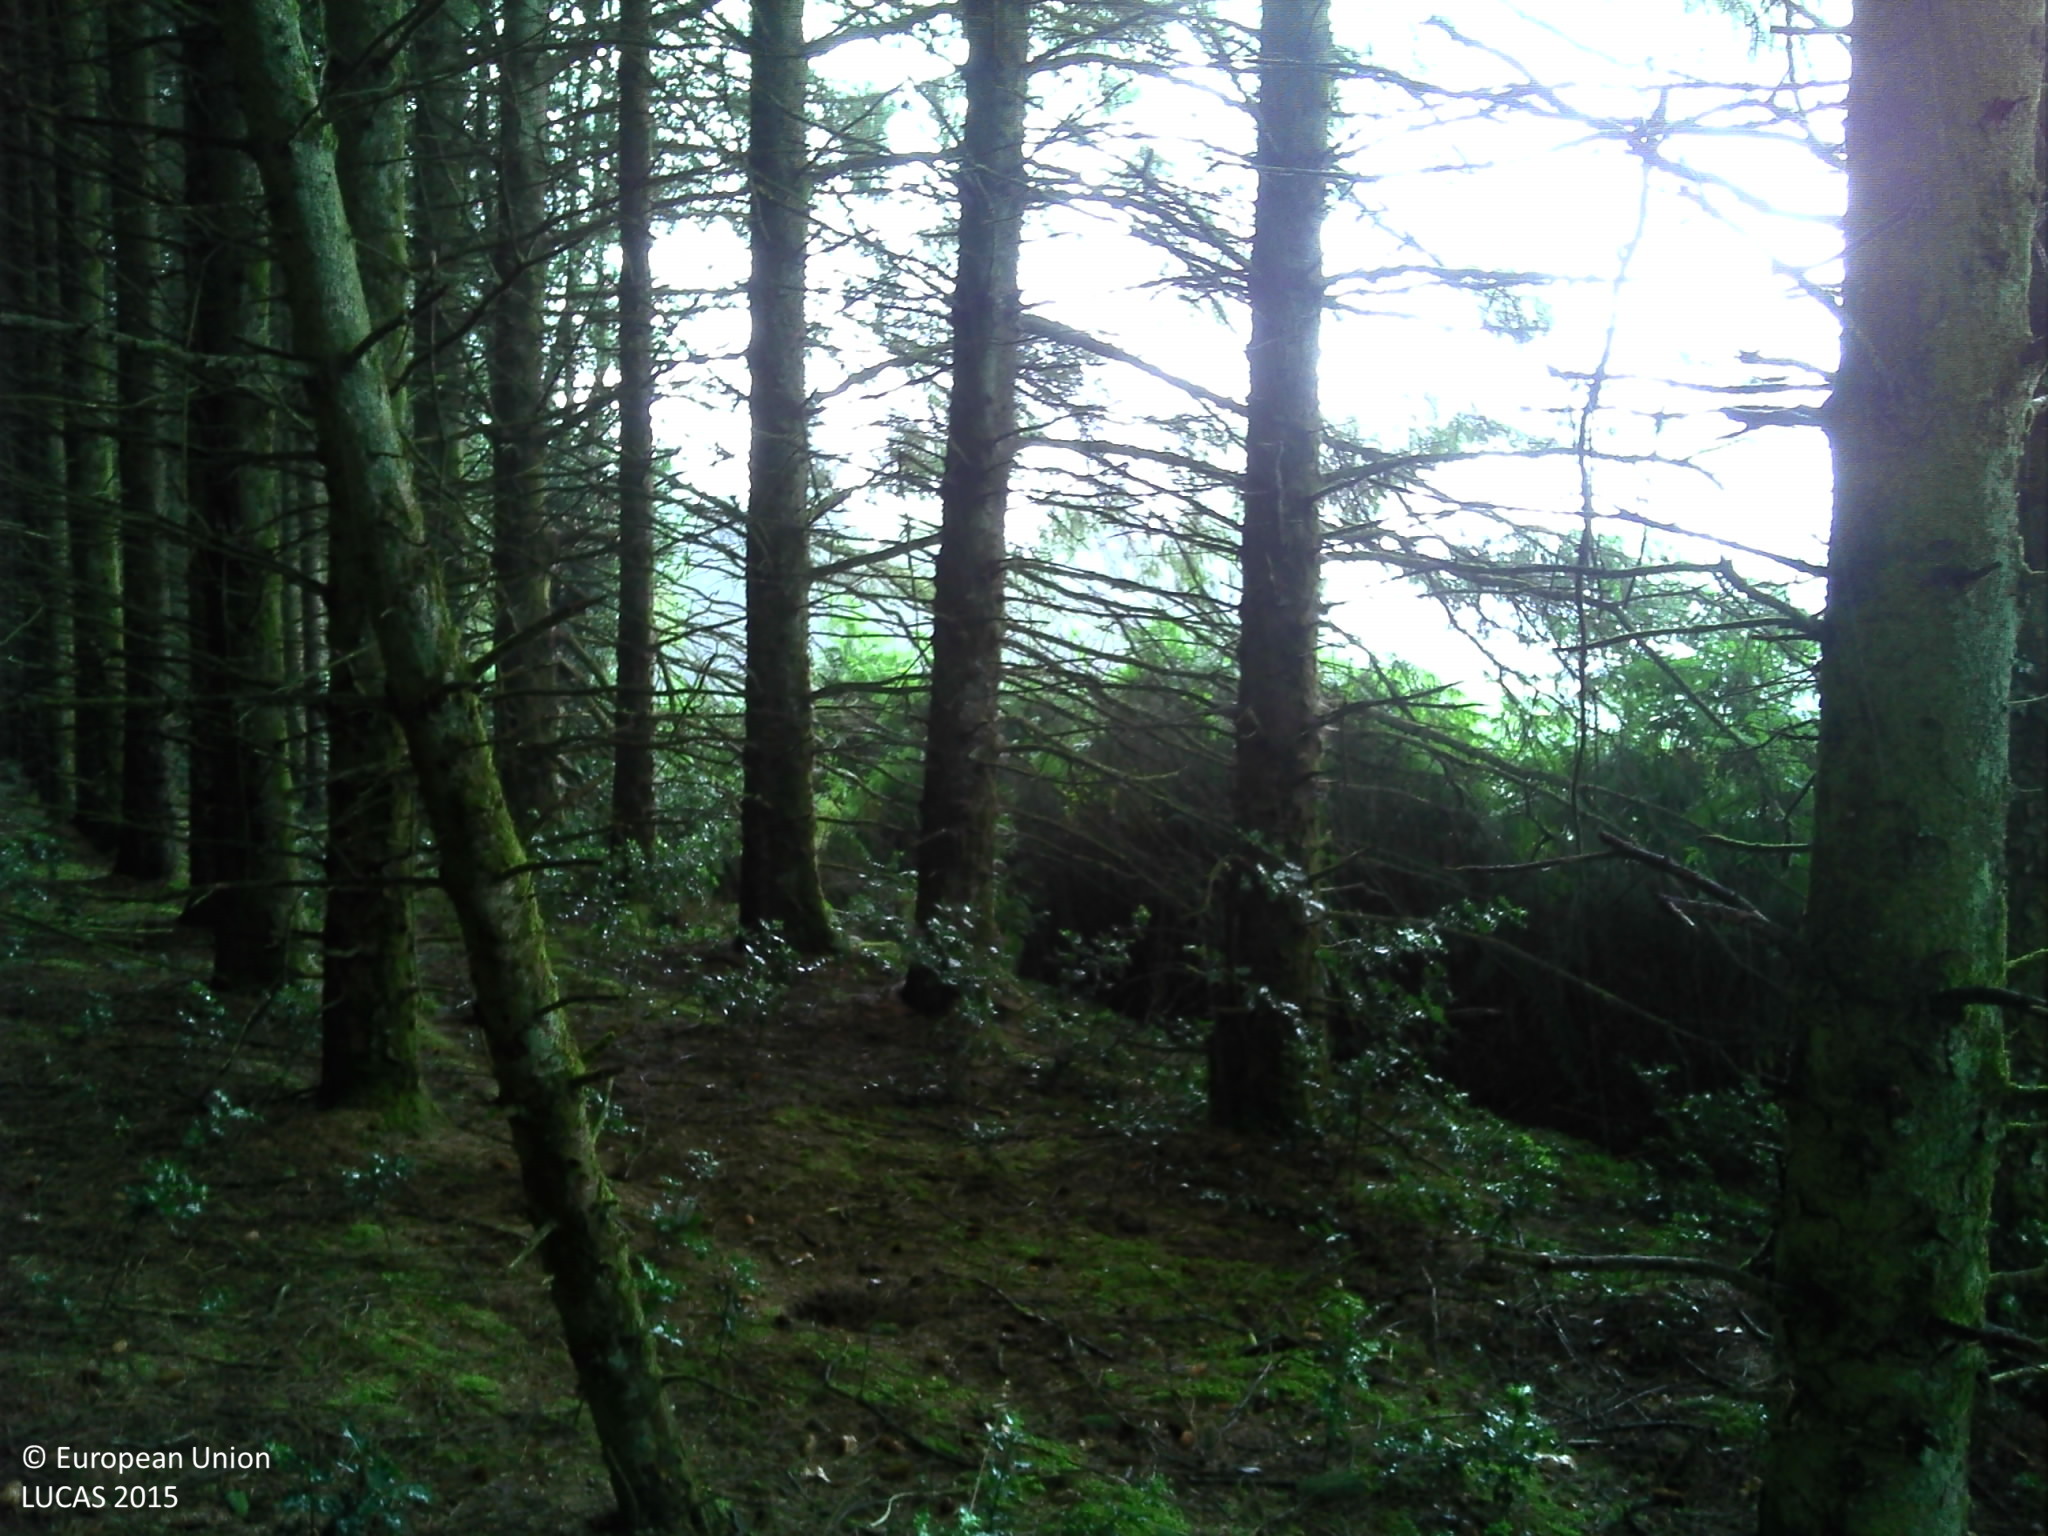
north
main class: Woodland
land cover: Other coniferous woodland
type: exotic forest
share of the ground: > 75 %
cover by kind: coniferous forest trees 90 %, herbaceous plants 10 %
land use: Forestry
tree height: > 5 m
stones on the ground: < 10 %
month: August
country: FR
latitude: 48.3998
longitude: -3.1333
